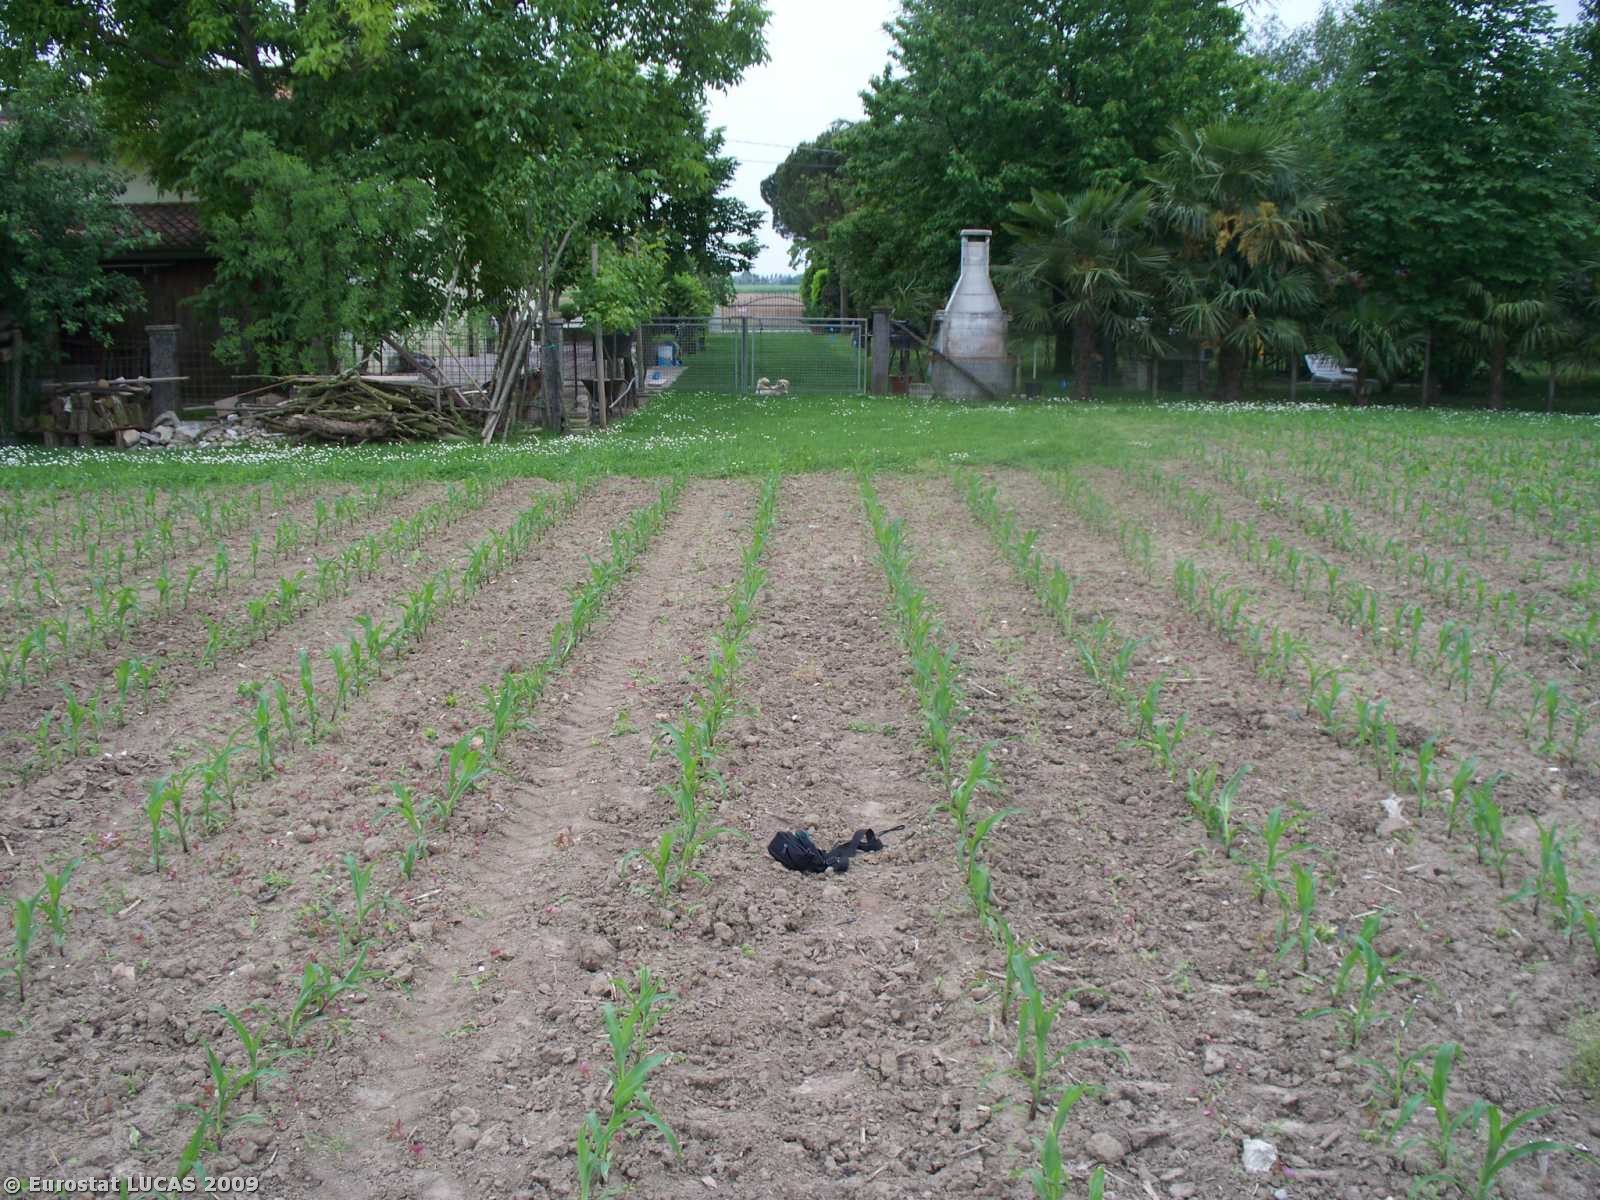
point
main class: Cropland
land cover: Maize
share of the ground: < 10 %
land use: Agriculture (excluding fallow land and kitchen gardens)
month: May
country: IT
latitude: 45.6881
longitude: 12.6286
